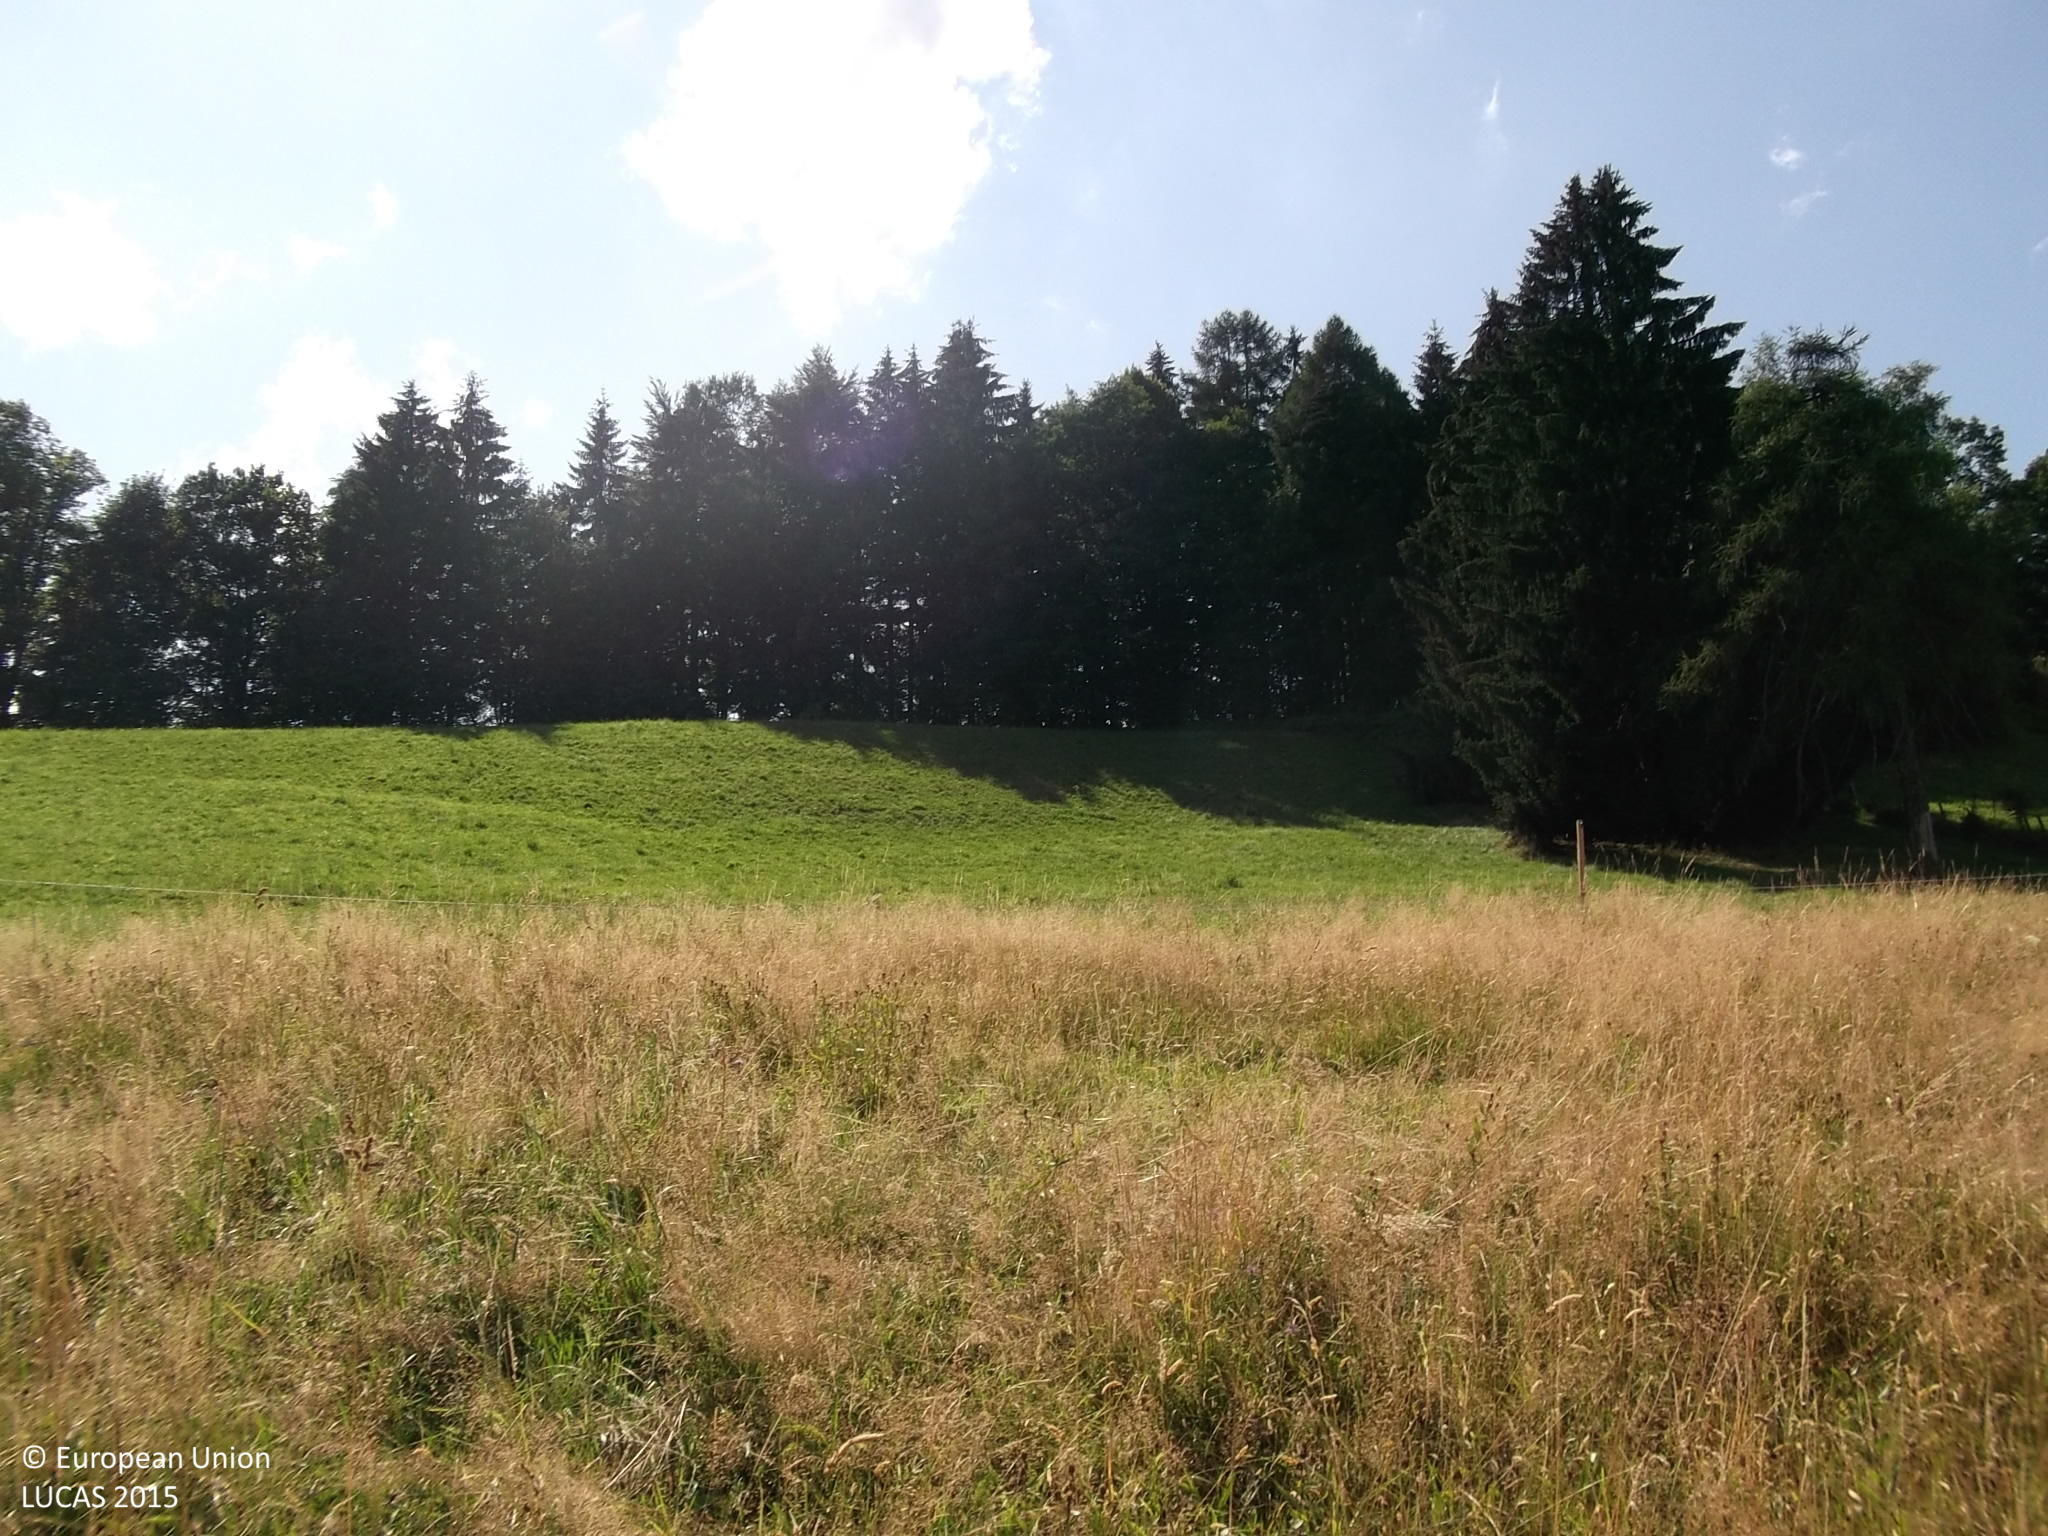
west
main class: Grassland
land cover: Grassland without tree/shrub cover
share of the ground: > 75 %
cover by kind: herbaceous plants 100 %
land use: Agriculture (excluding fallow land and kitchen gardens)
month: July
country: AT
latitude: 47.9349
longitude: 13.4659
